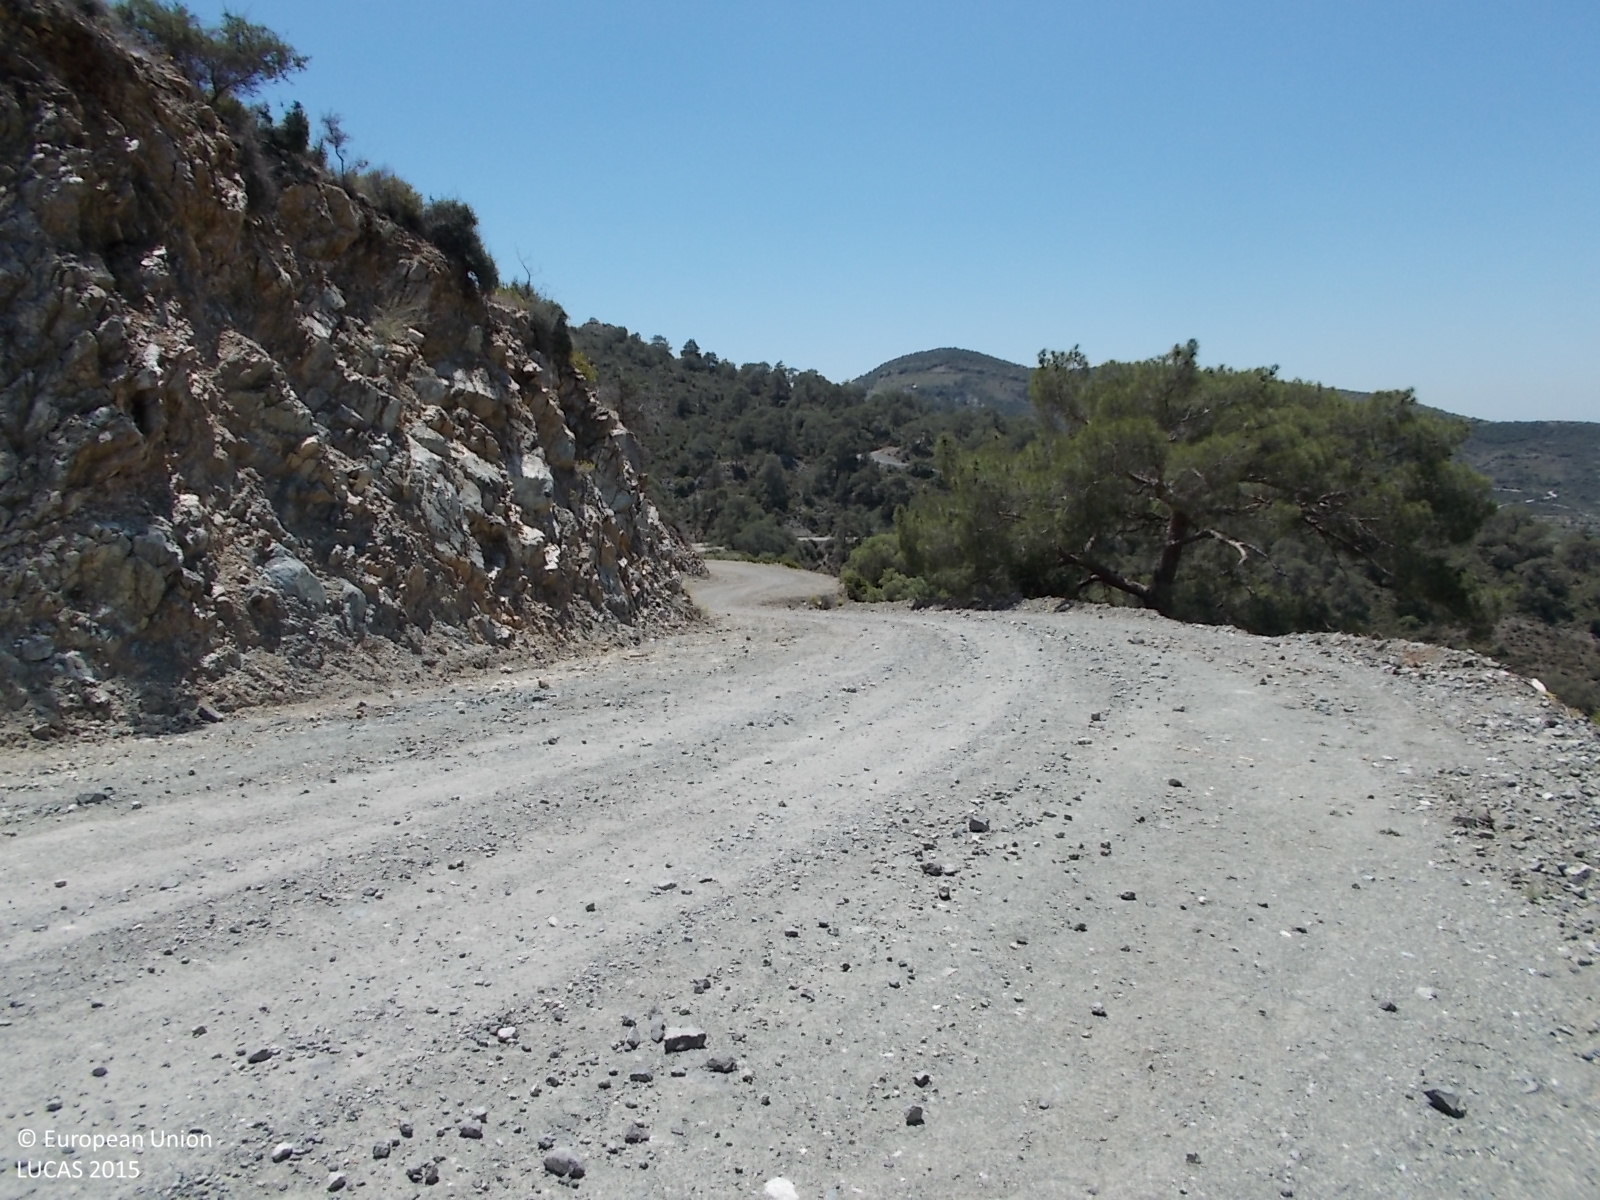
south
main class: Woodland
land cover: Pine dominated coniferous woodland
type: coniferous forest of the mediterranean region
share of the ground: 25 - 50 %
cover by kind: unconsolidated bare surface 55 %, coniferous forest trees 45 %
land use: Forestry
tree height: > 5 m
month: May
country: CY
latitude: 34.8063
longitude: 33.0252
